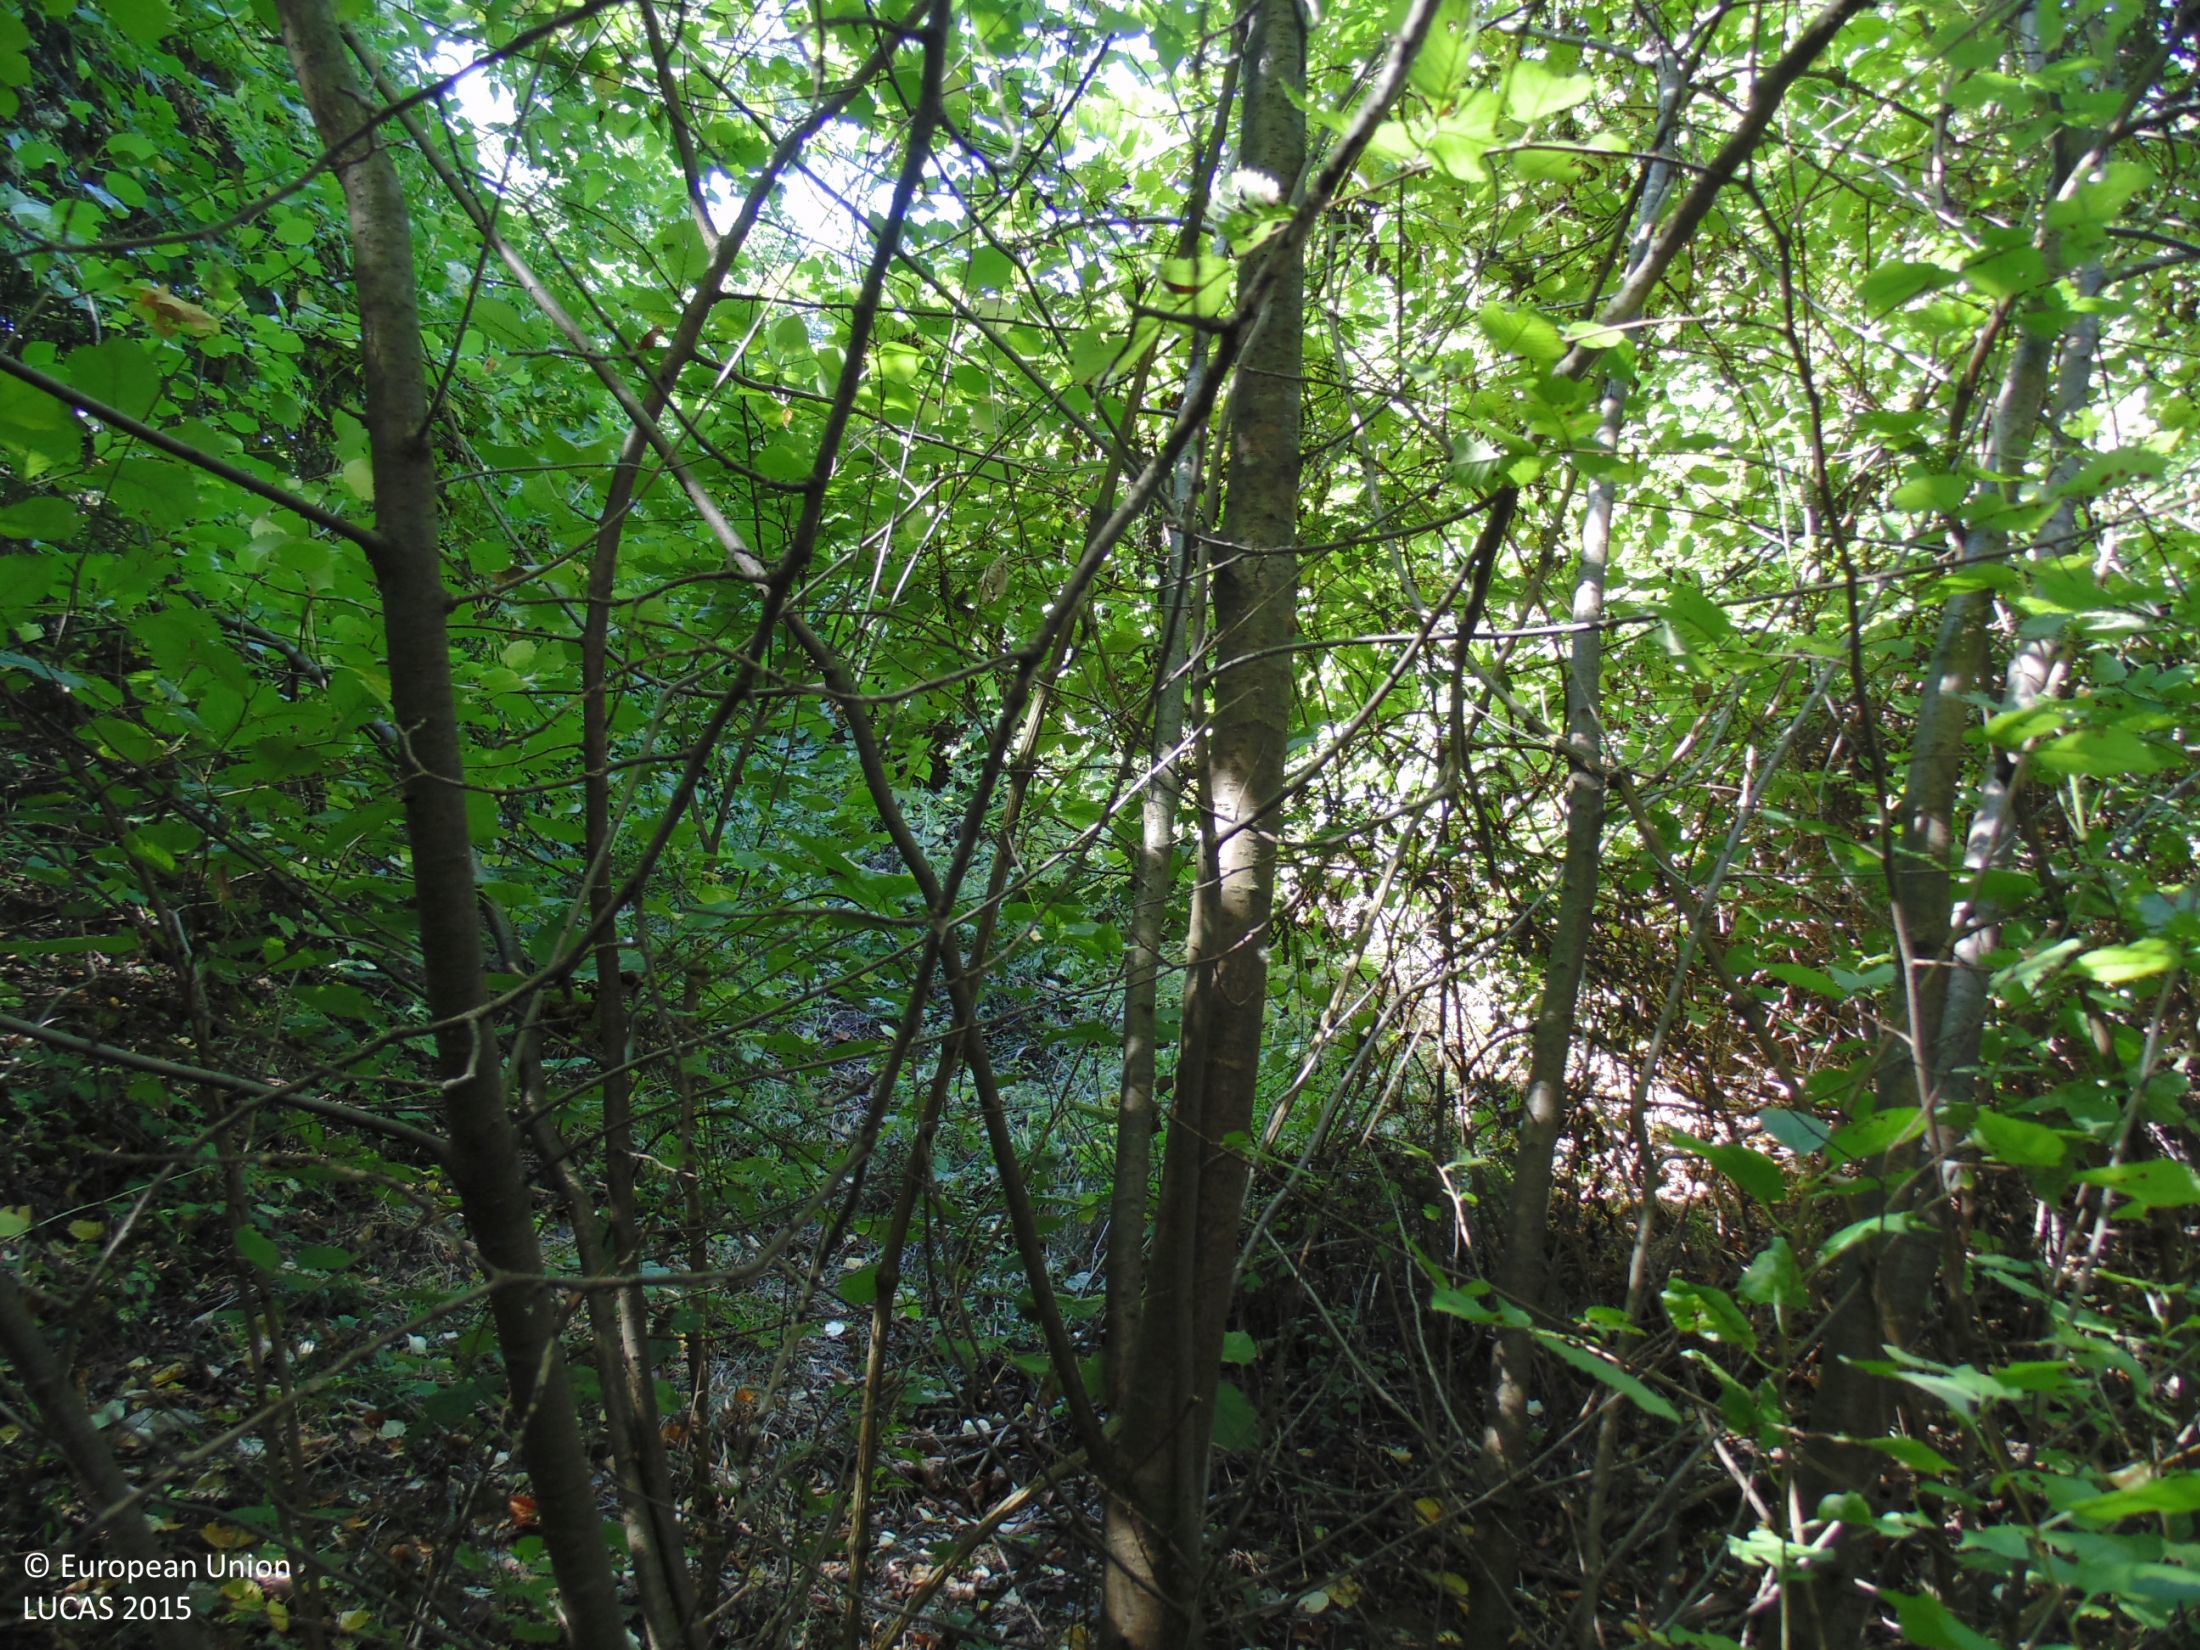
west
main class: Woodland
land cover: Broadleaved woodland
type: mesophytic deciduous forest
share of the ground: > 75 %
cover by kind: broadleaved forest trees 90 %, shrubs 5 %, unconsolidated bare surface 5 %
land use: Forestry
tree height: > 5 m
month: September
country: BG
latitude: 44.1162
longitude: 26.9802
